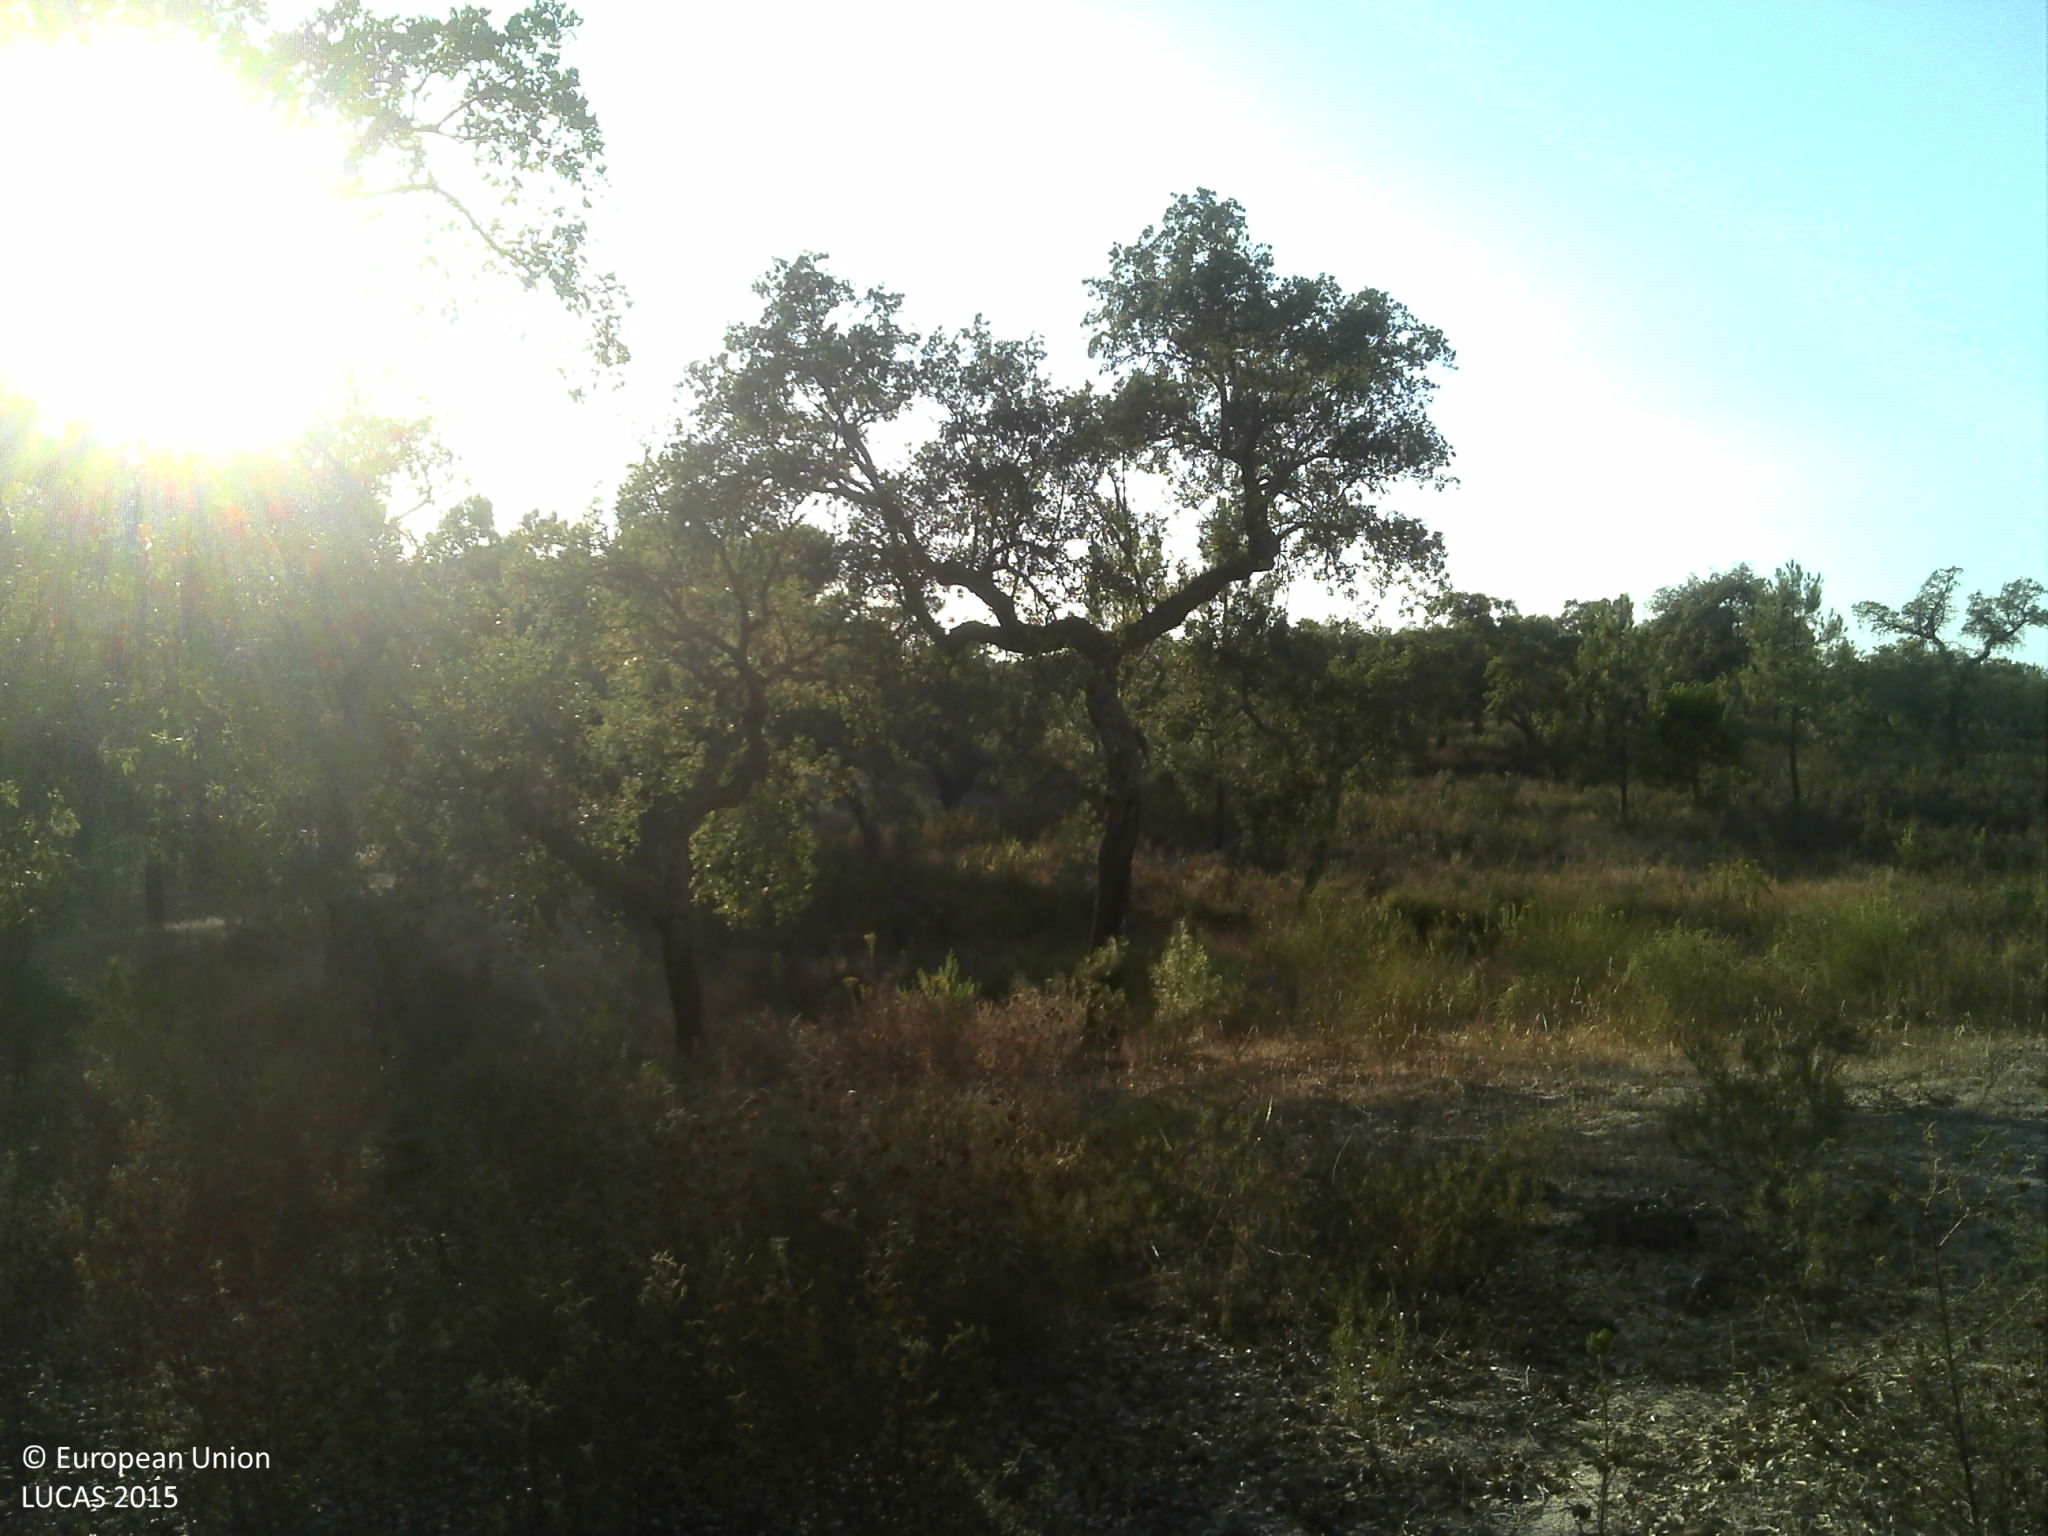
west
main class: Woodland
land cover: Broadleaved woodland
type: broadleaved evergreen forest
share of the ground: 25 - 50 %
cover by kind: broadleaved forest trees 50 %, unconsolidated bare surface 25 %, herbaceous plants 15 %, shrubs 10 %
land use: Forestry
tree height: > 5 m
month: July
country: PT
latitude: 38.9370
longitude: -8.2007
